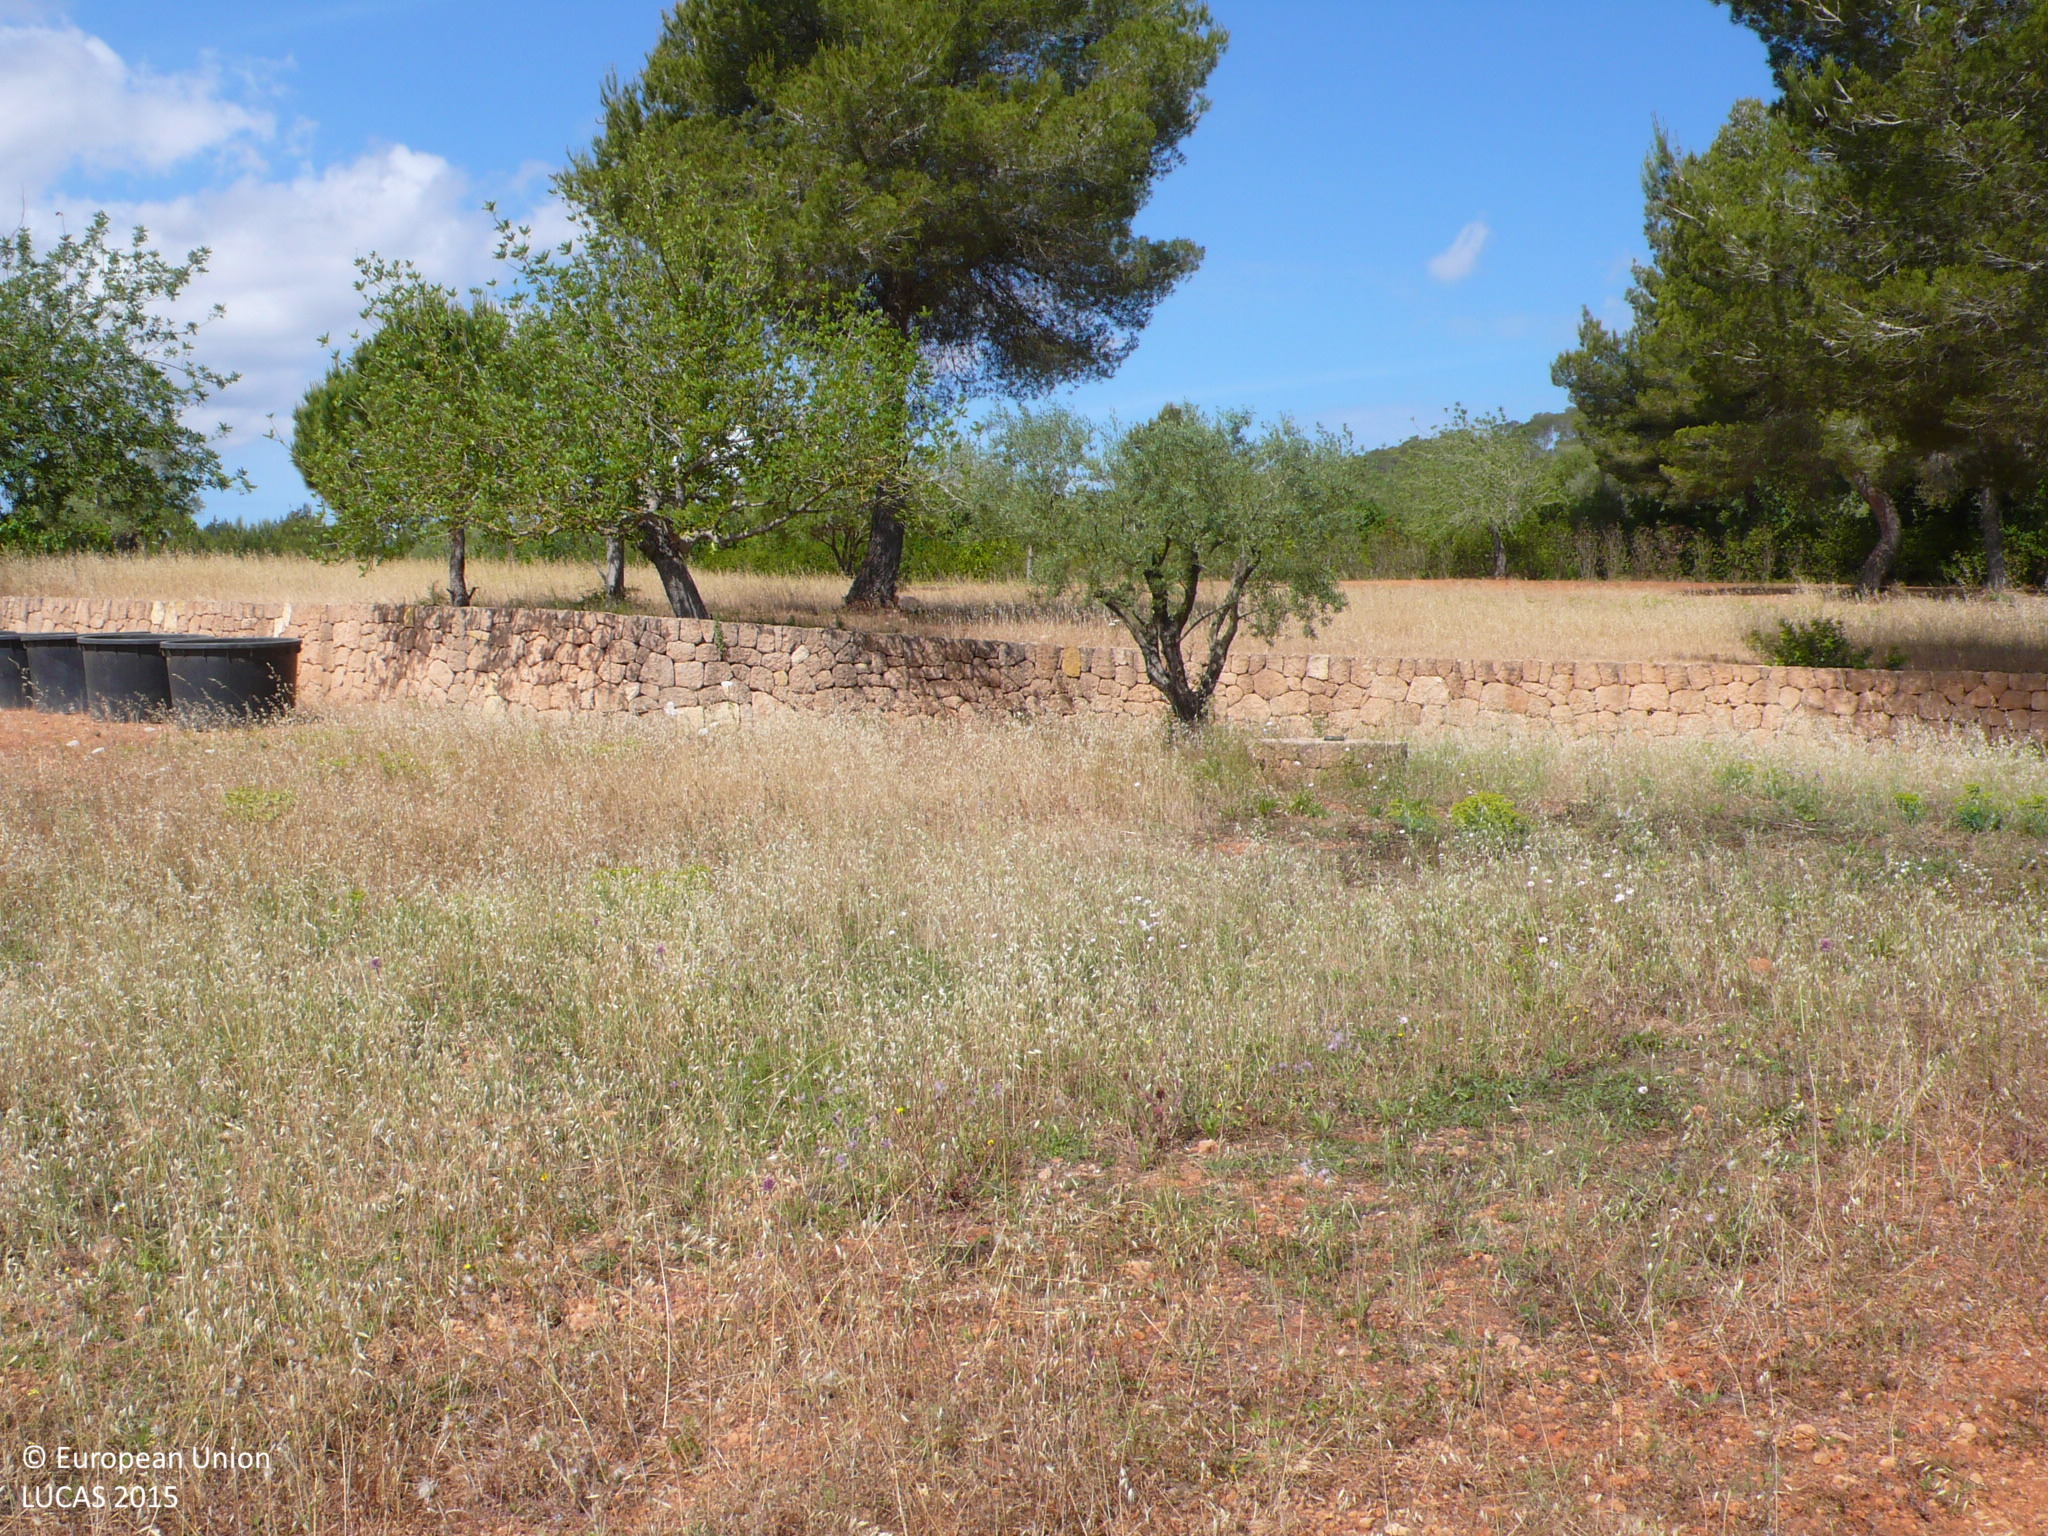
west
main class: Grassland
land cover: Spontaneously vegetated surfaces
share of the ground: 25 - 50 %
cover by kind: consolidated bare surface 60 %, herbaceous plants 40 %
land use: Construction
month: May
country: ES
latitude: 38.9863
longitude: 1.4807
